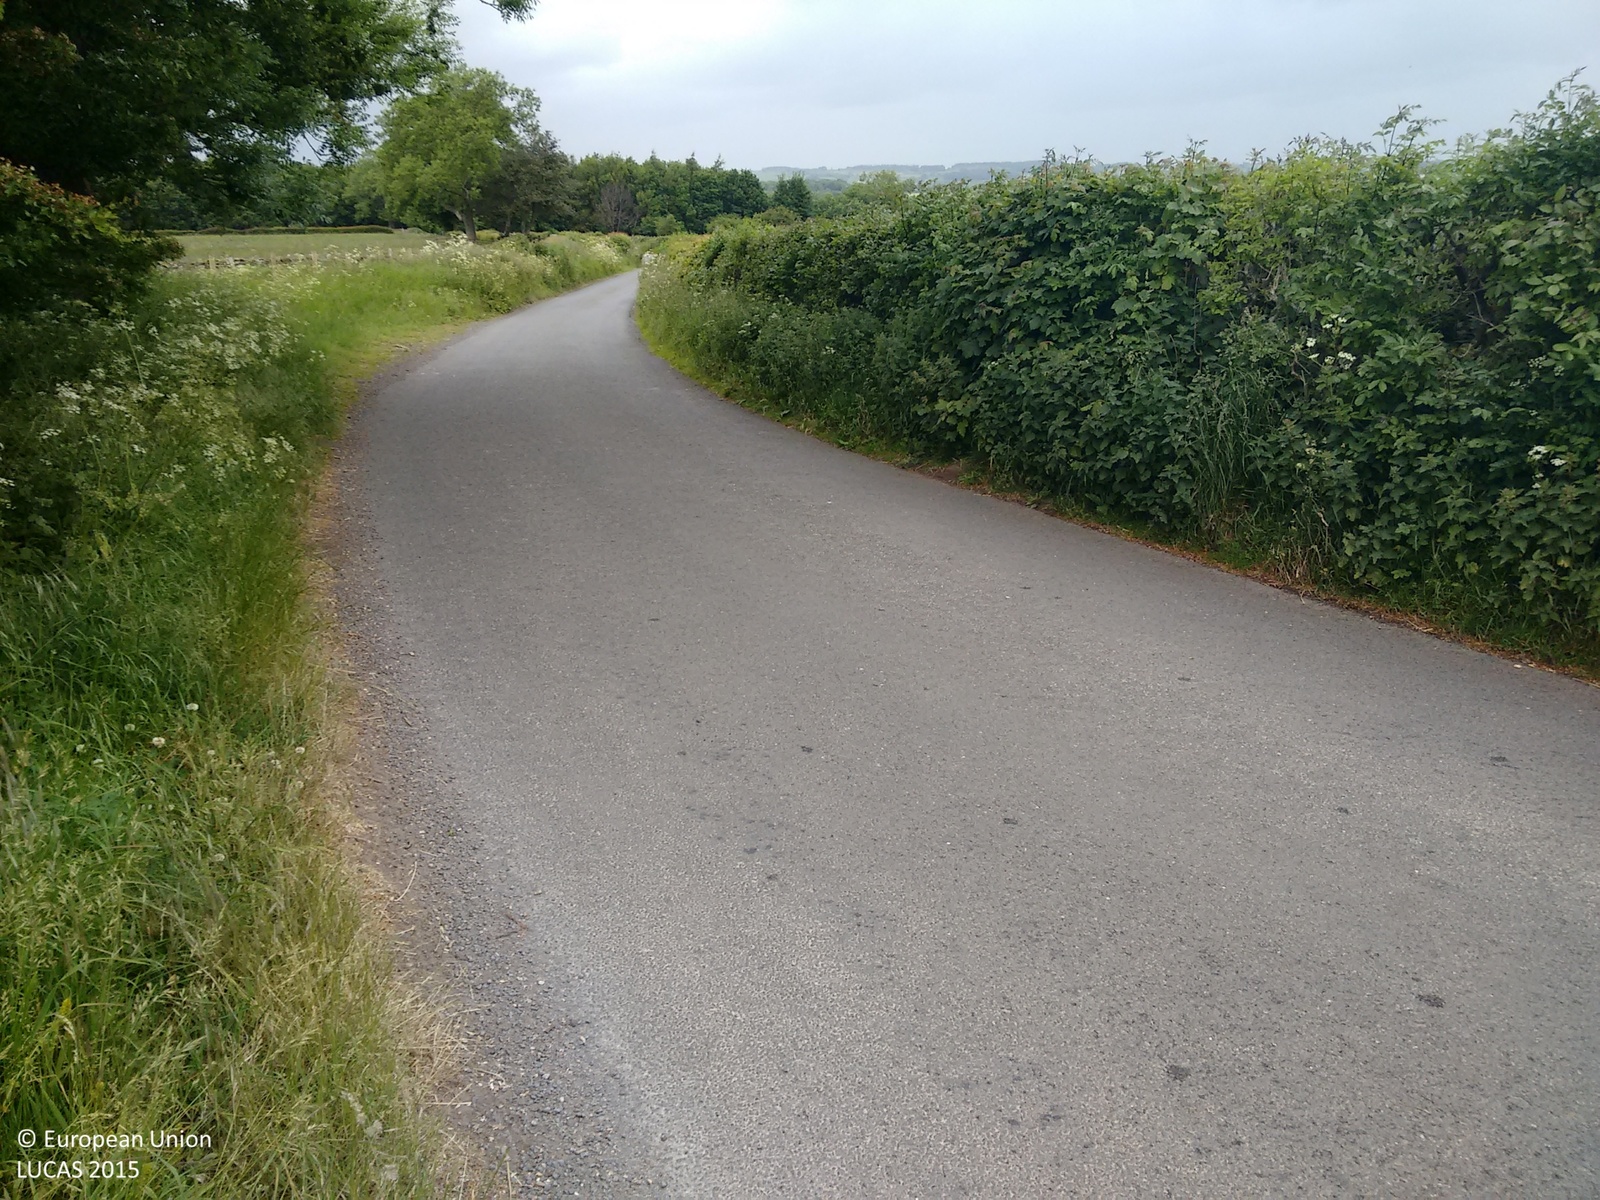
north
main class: Grassland
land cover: Grassland without tree/shrub cover
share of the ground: > 75 %
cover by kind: herbaceous plants 100 %
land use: Agriculture (excluding fallow land and kitchen gardens)
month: June
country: GB
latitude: 54.2975
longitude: -1.7767
